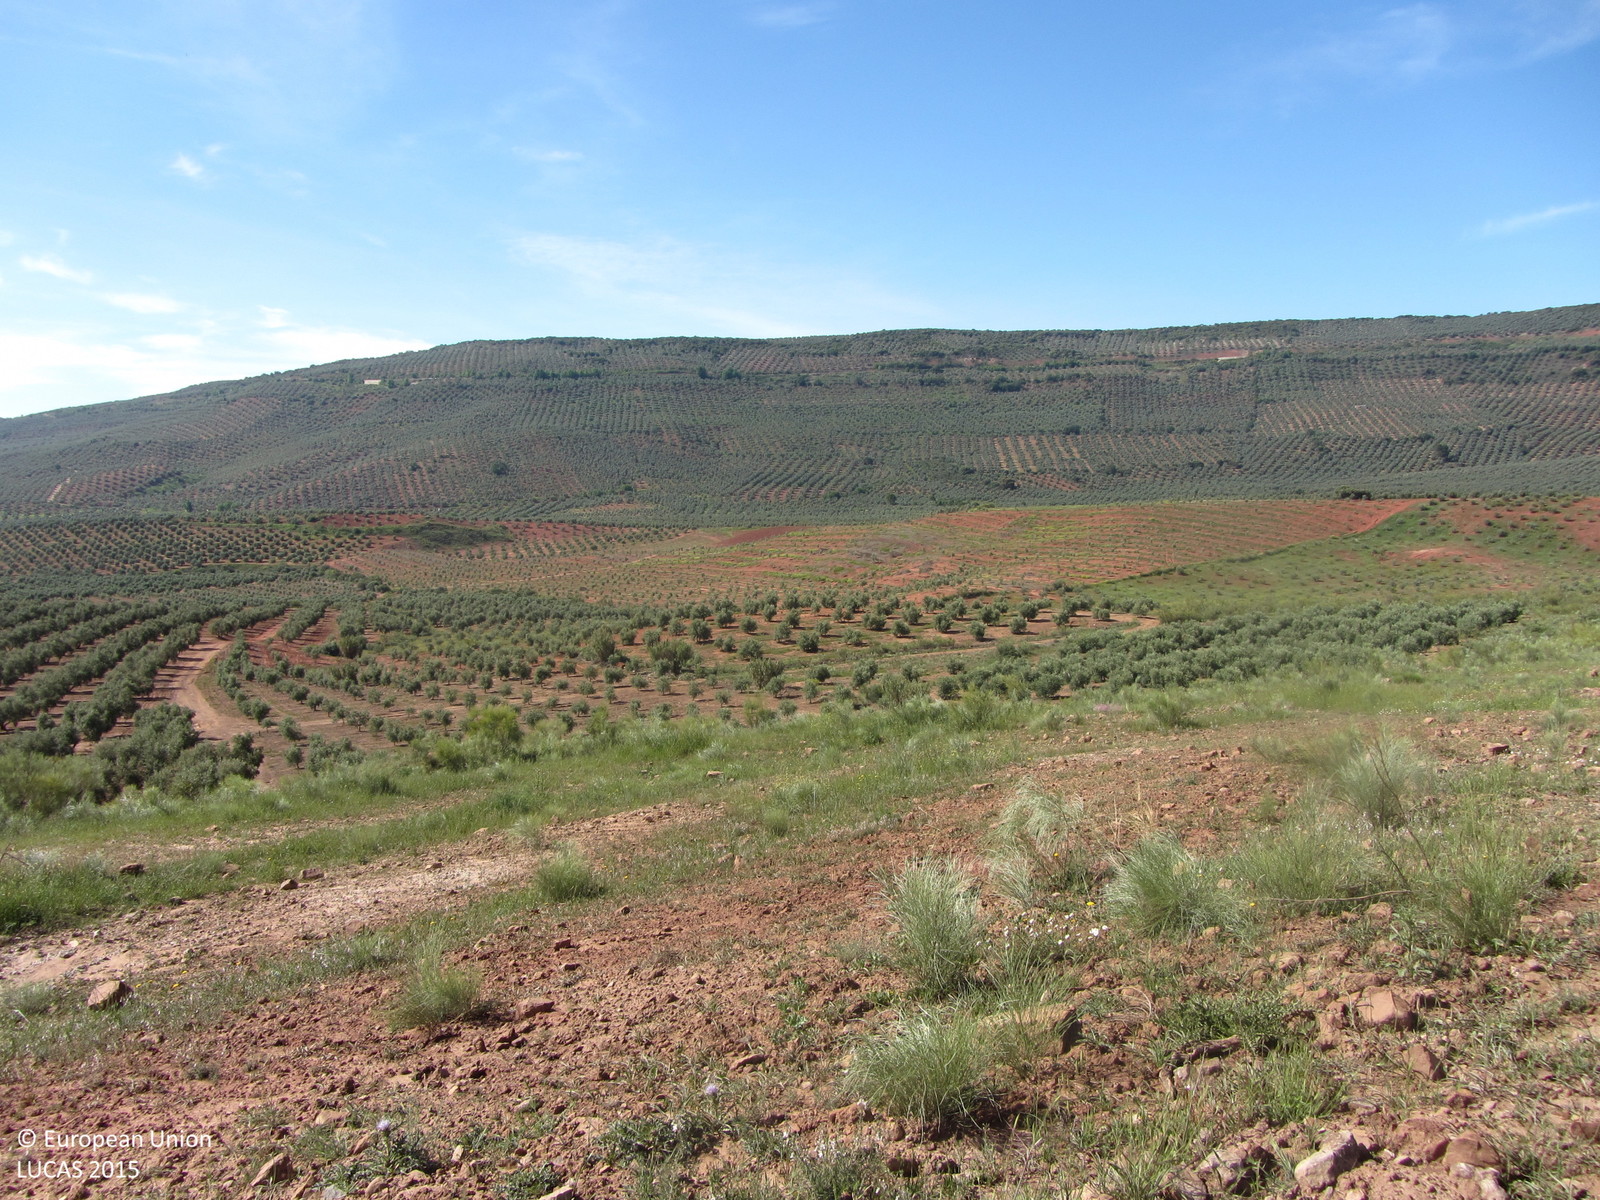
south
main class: Grassland
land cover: Spontaneously vegetated surfaces
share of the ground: 25 - 50 %
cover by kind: consolidated bare surface 65 %, herbaceous plants 35 %
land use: Semi-natural and natural areas not in use
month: May
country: ES
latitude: 38.2722
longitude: -3.0658
